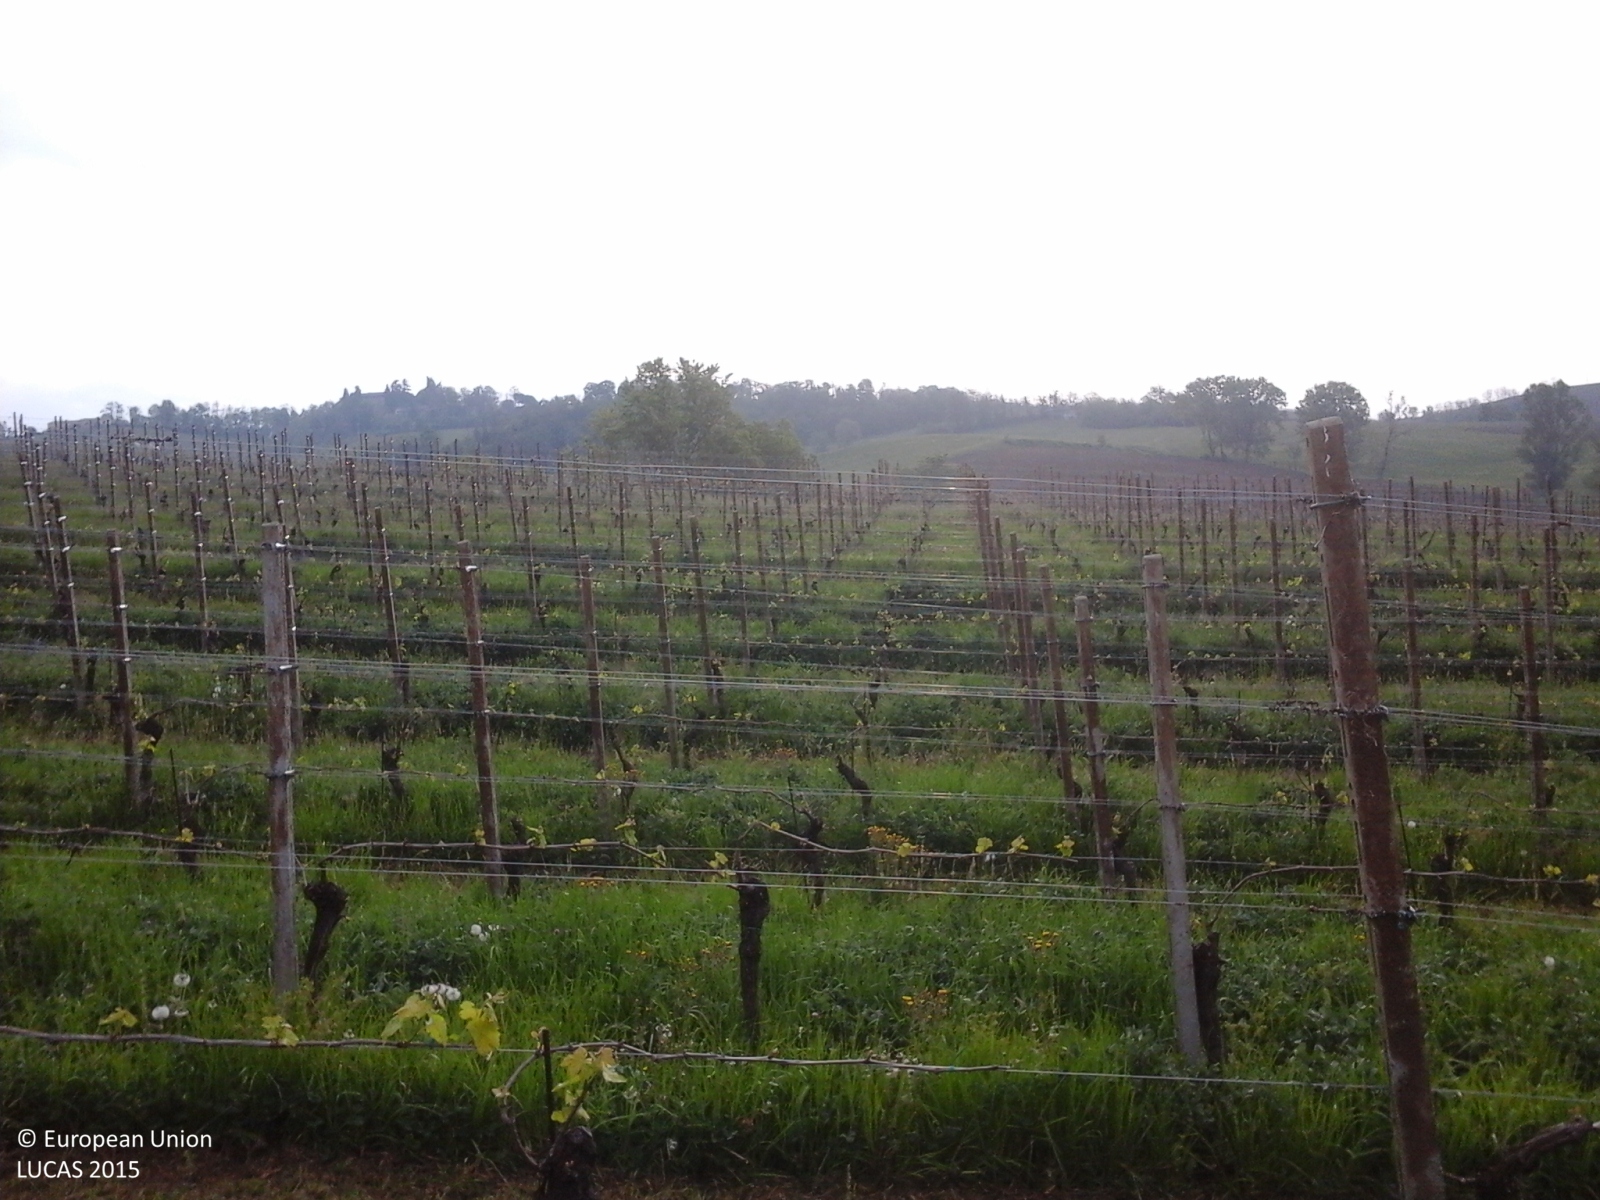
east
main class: Cropland
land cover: Vineyards
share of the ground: < 10 %
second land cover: Grassland without tree/shrub cover
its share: > 75 %
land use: Agriculture (excluding fallow land and kitchen gardens)
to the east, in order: Vineyards; Grassland without tree/shrub cover; Grassland with sparse tree/shrub cover; Tracks; Fences; Shrubland with sparse tree cover; Rivers and streams; Broadleaved woodland; Other bare soil
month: April
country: IT
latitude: 44.9618
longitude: 9.3800
